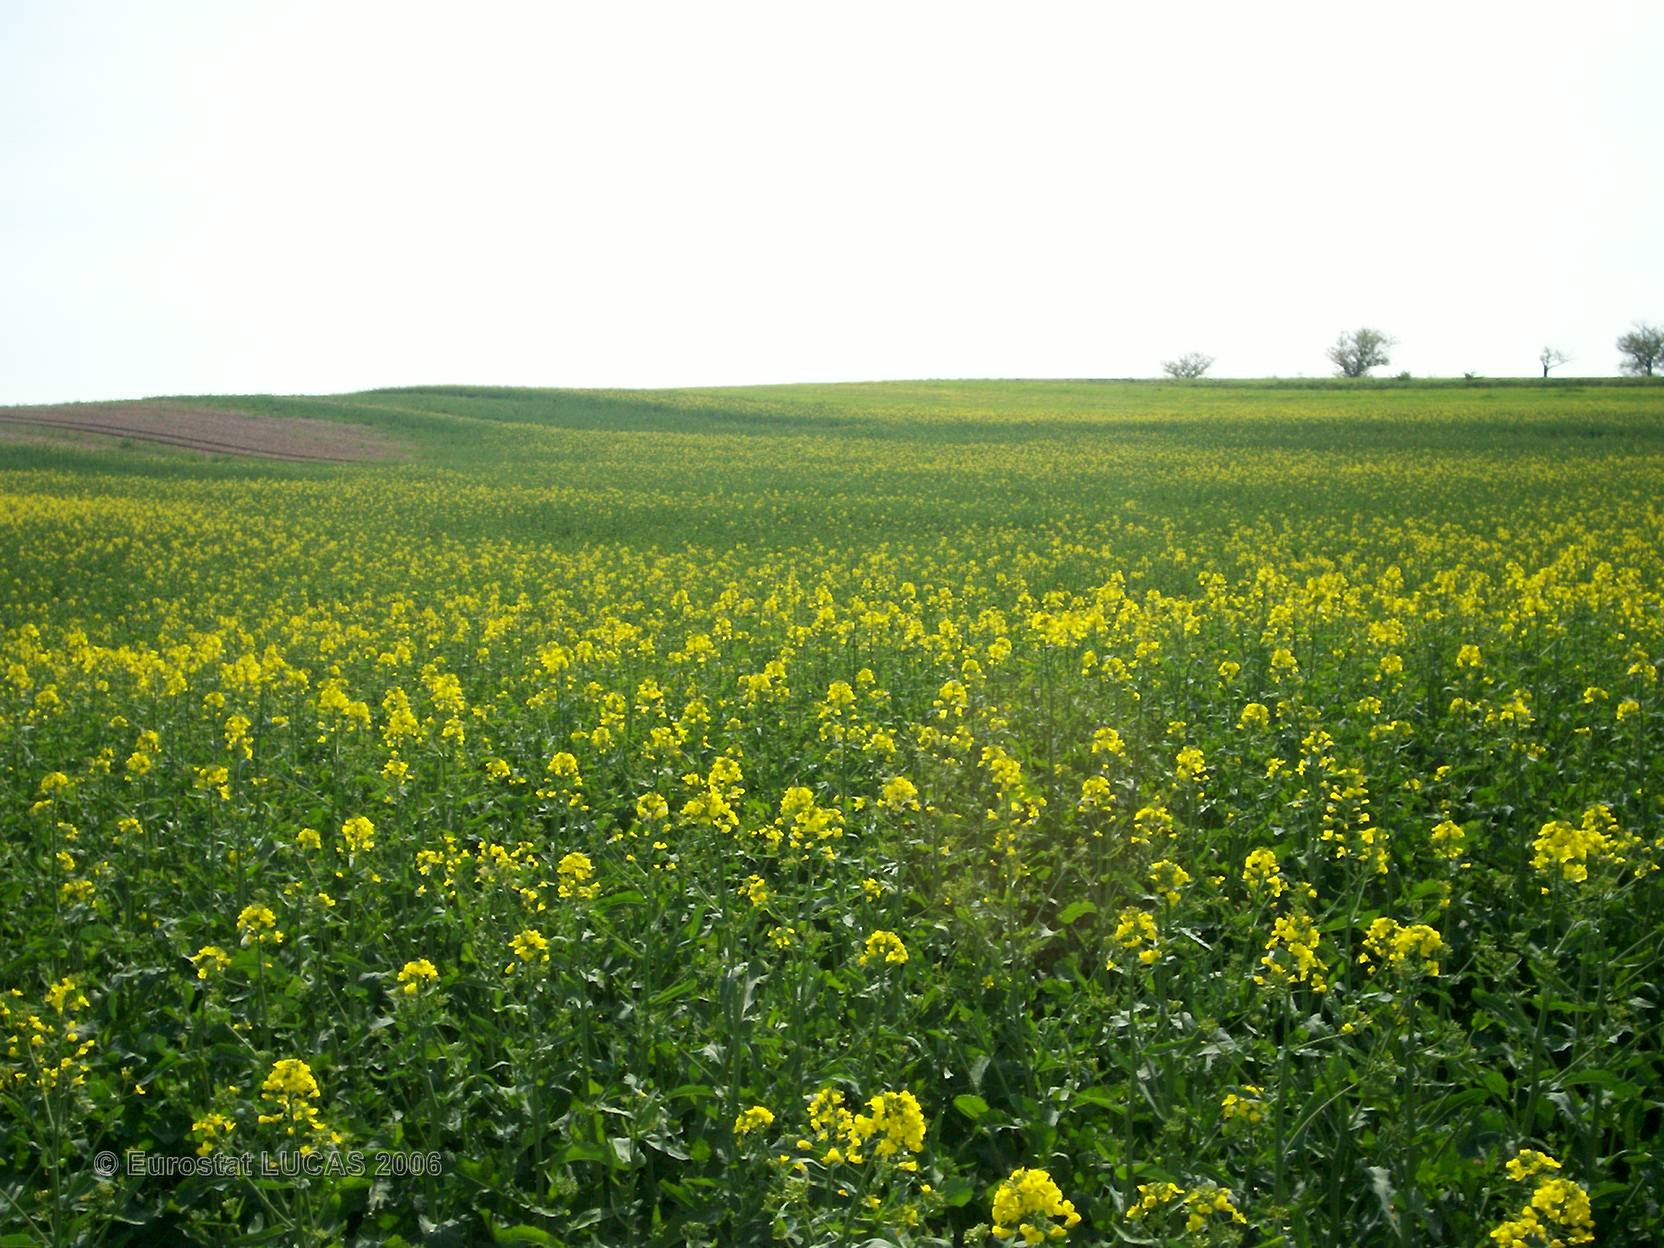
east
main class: Cropland
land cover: Rape and turnip rape
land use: Agriculture (excluding fallow land and kitchen gardens)
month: May
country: FR
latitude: 48.9550
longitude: 6.9277
